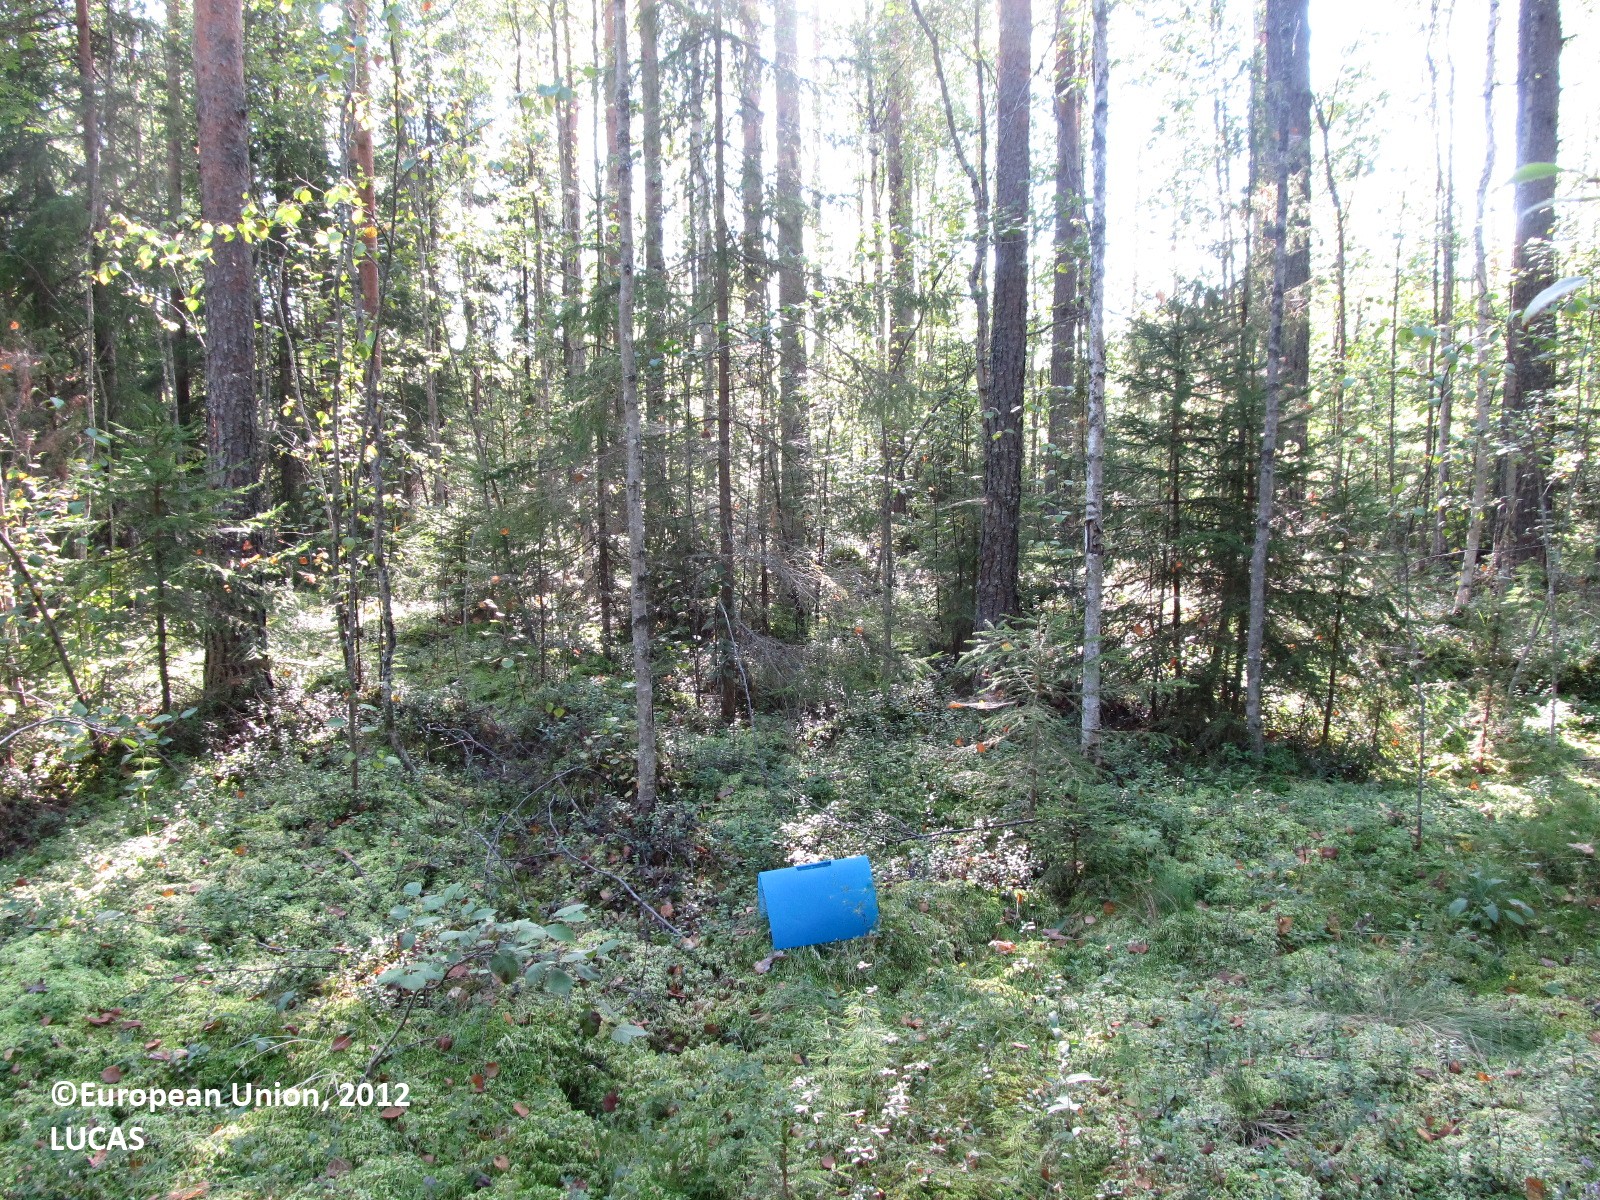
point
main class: Woodland
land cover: Pine dominated mixed woodland
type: boreal forest
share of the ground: 50 - 75 %
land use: Forestry
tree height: > 5 m
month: August
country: FI
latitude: 62.1672
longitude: 27.5078
